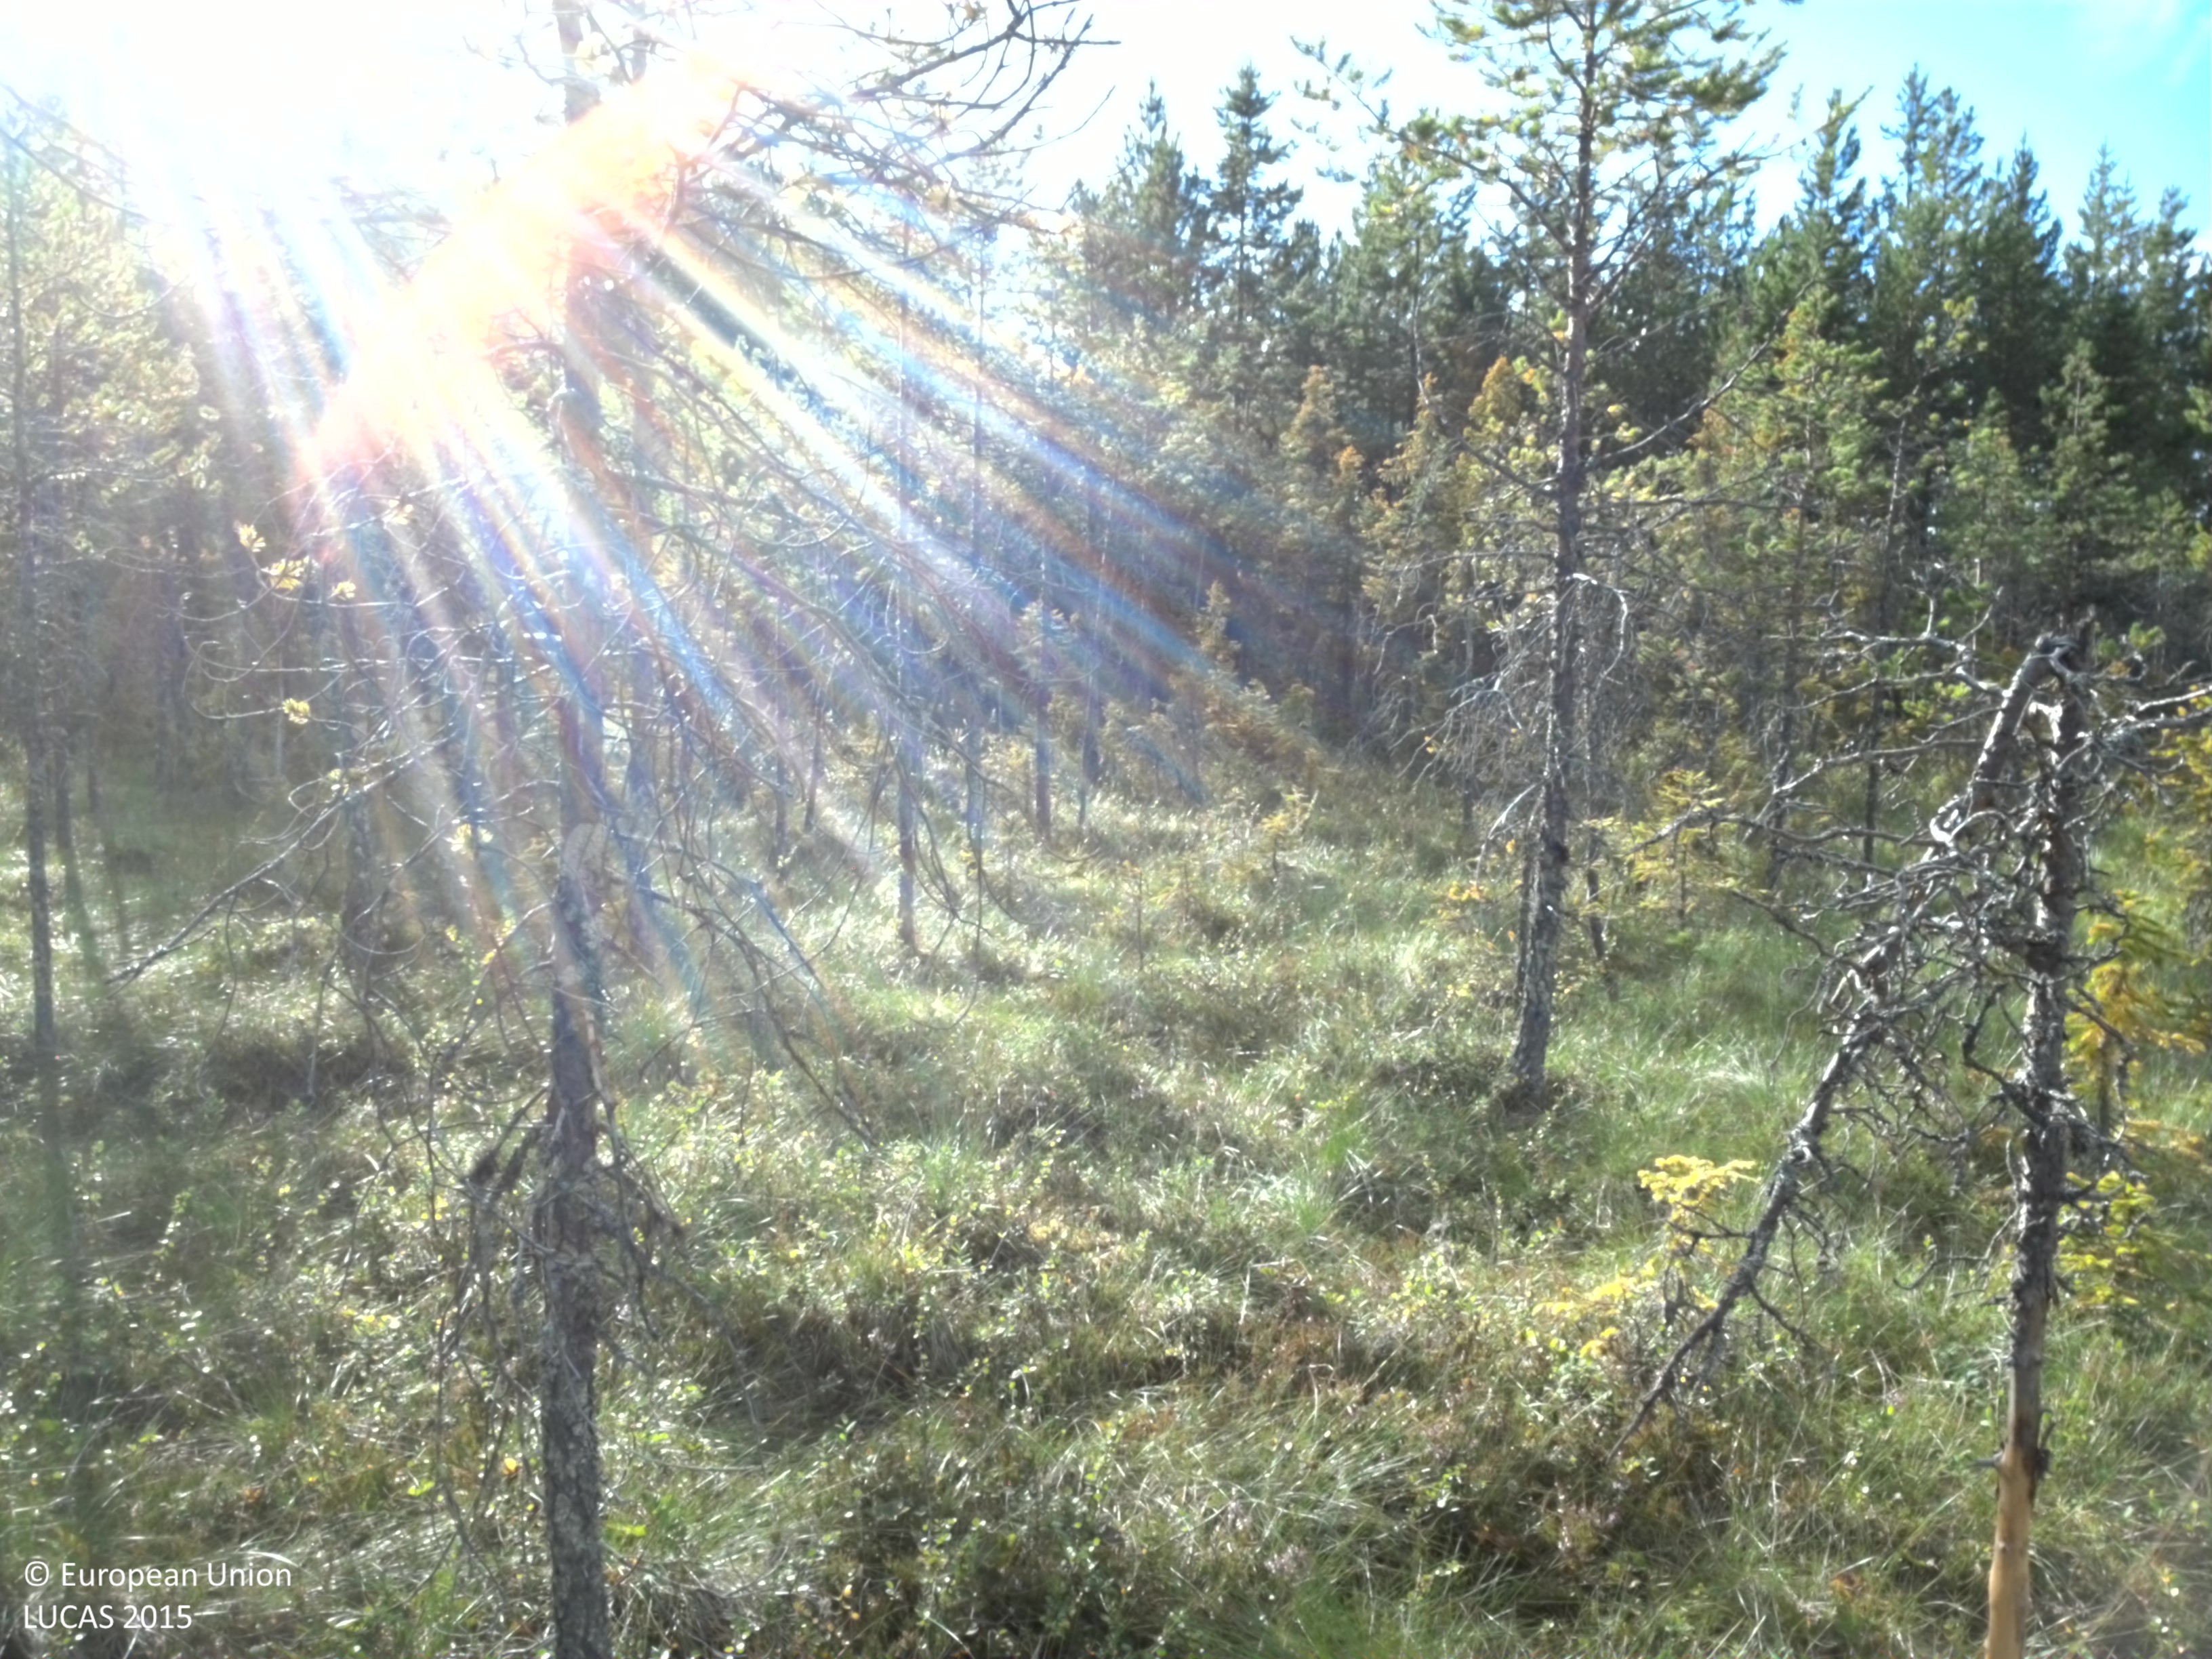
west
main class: Woodland
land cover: Pine dominated coniferous woodland
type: boreal forest
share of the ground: 10 - 25 %
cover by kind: shrubs 70 %, coniferous forest trees 15 %, herbaceous plants 10 %, lichens and mosses 5 %
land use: Semi-natural and natural areas not in use
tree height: > 5 m
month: August
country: SE
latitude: 66.1635
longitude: 22.6846
